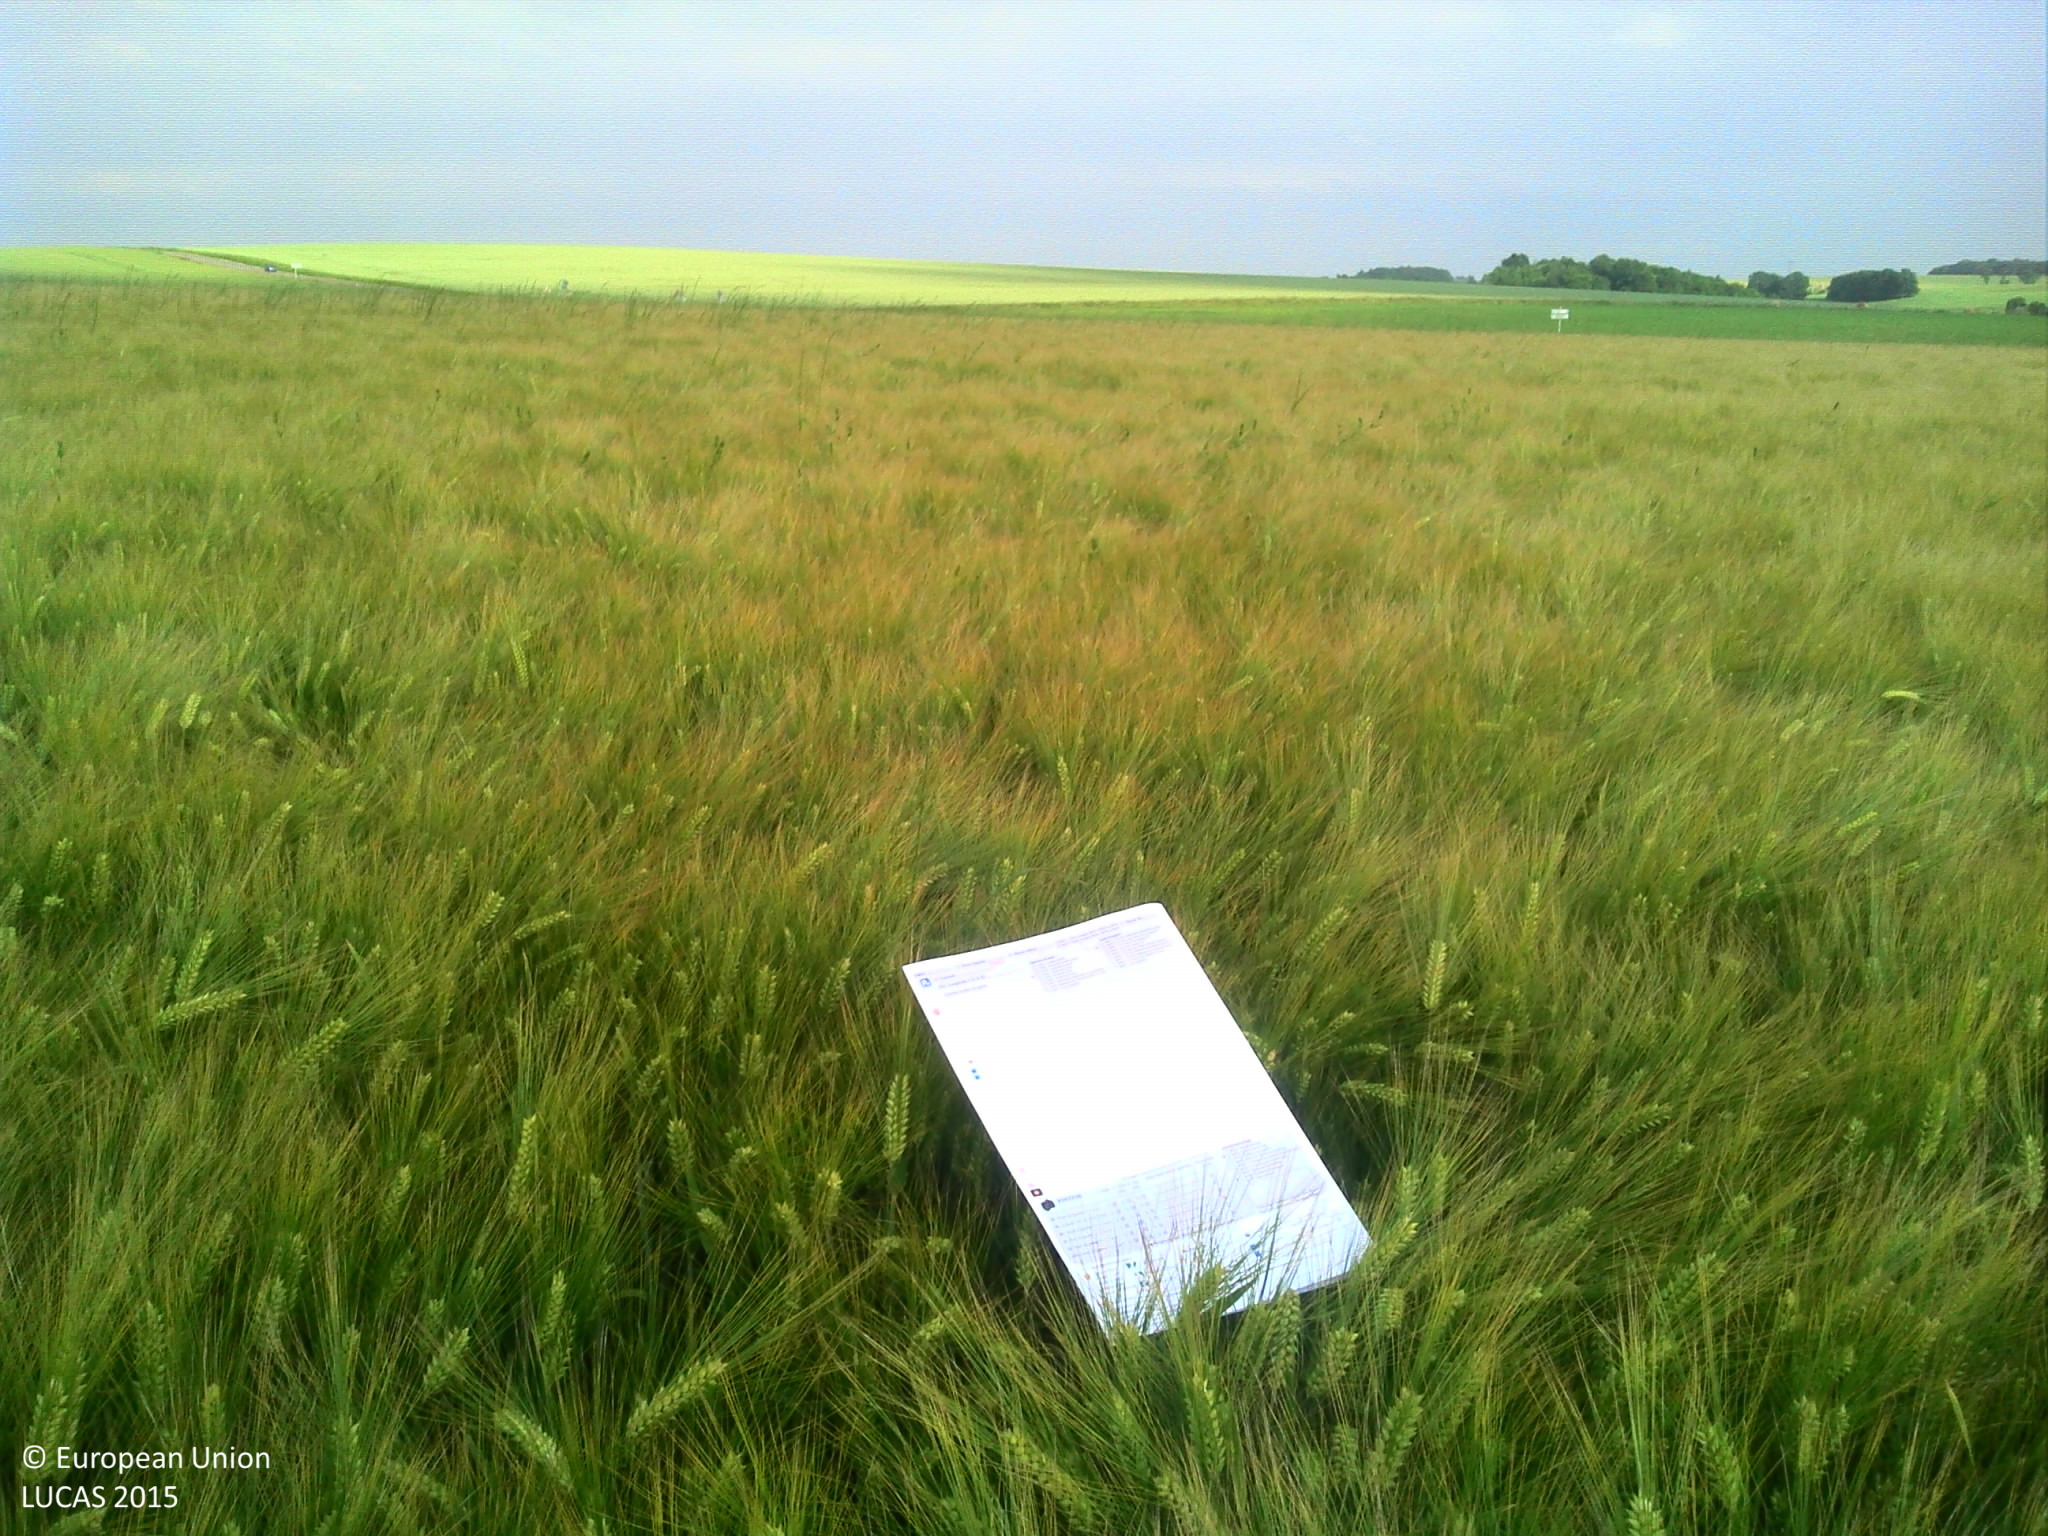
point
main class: Cropland
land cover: Barley
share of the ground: > 75 %
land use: Agriculture (excluding fallow land and kitchen gardens)
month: June
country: FR
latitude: 48.4363
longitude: 5.0379
